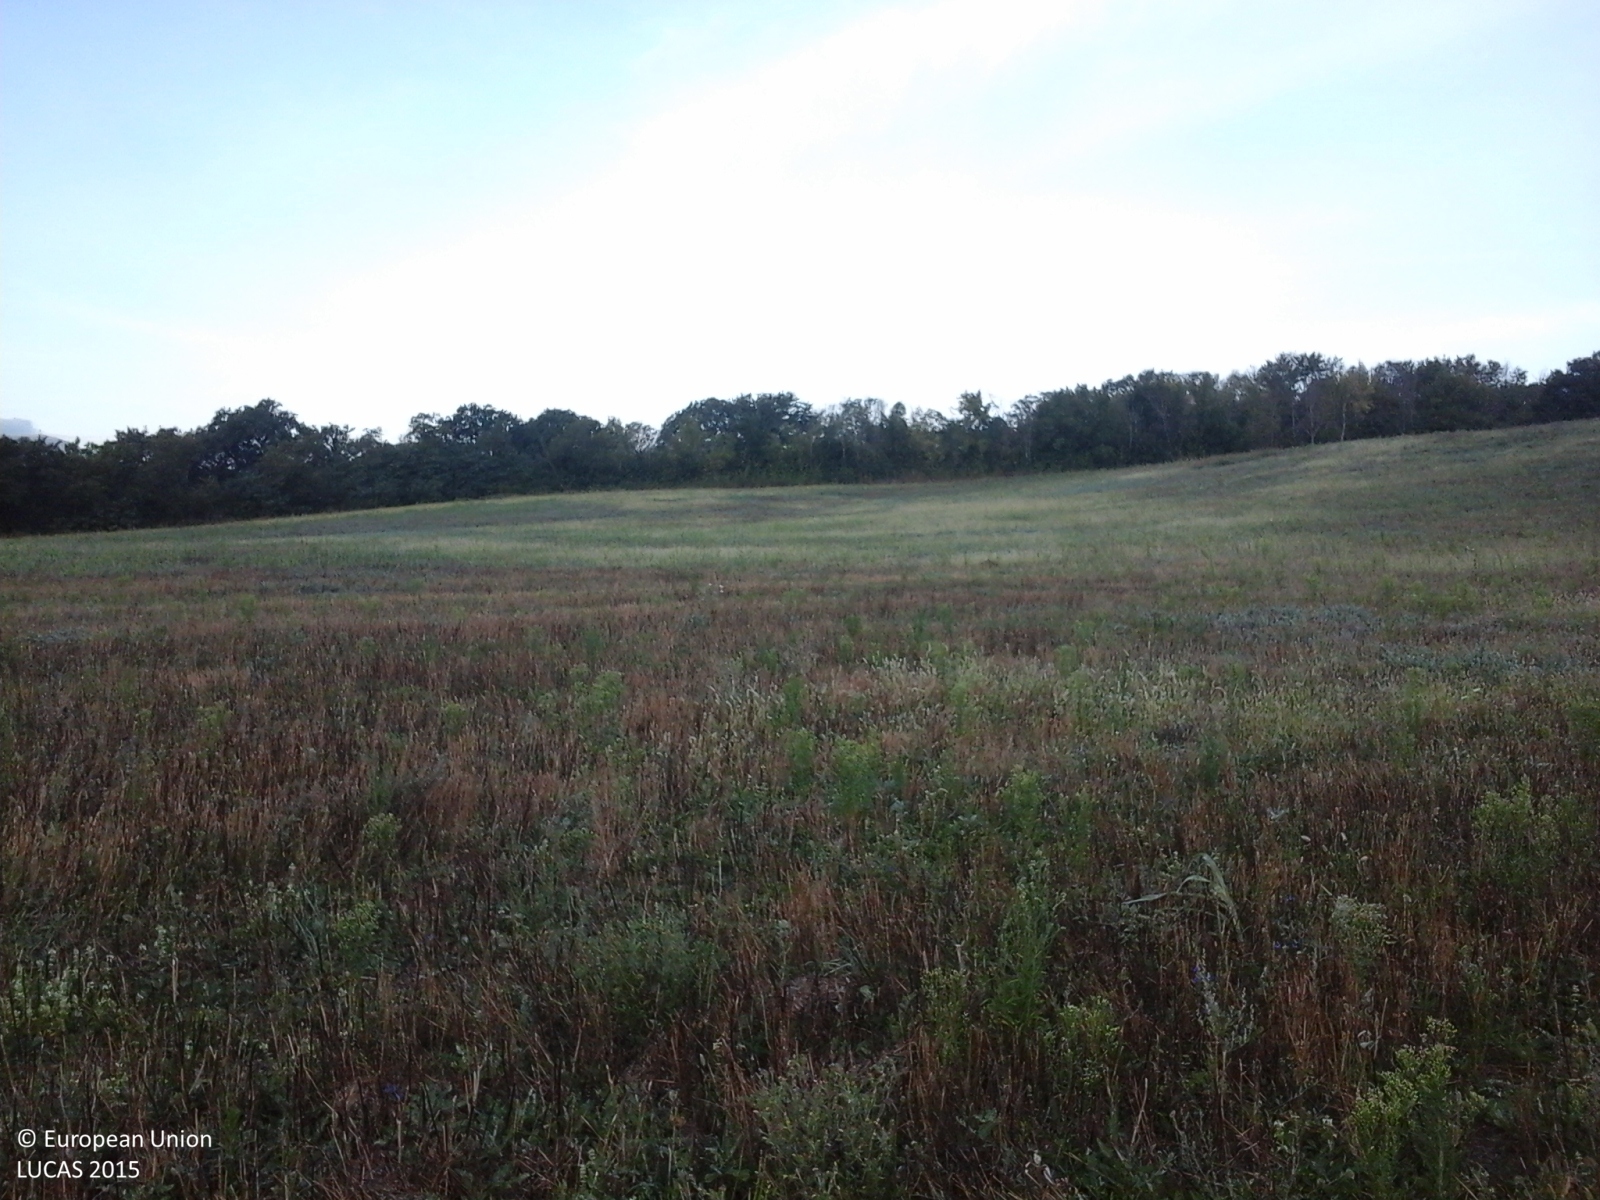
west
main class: Cropland
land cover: Barley
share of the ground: < 10 %
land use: Agriculture (excluding fallow land and kitchen gardens)
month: September
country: IT
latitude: 43.3326
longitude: 12.9891
